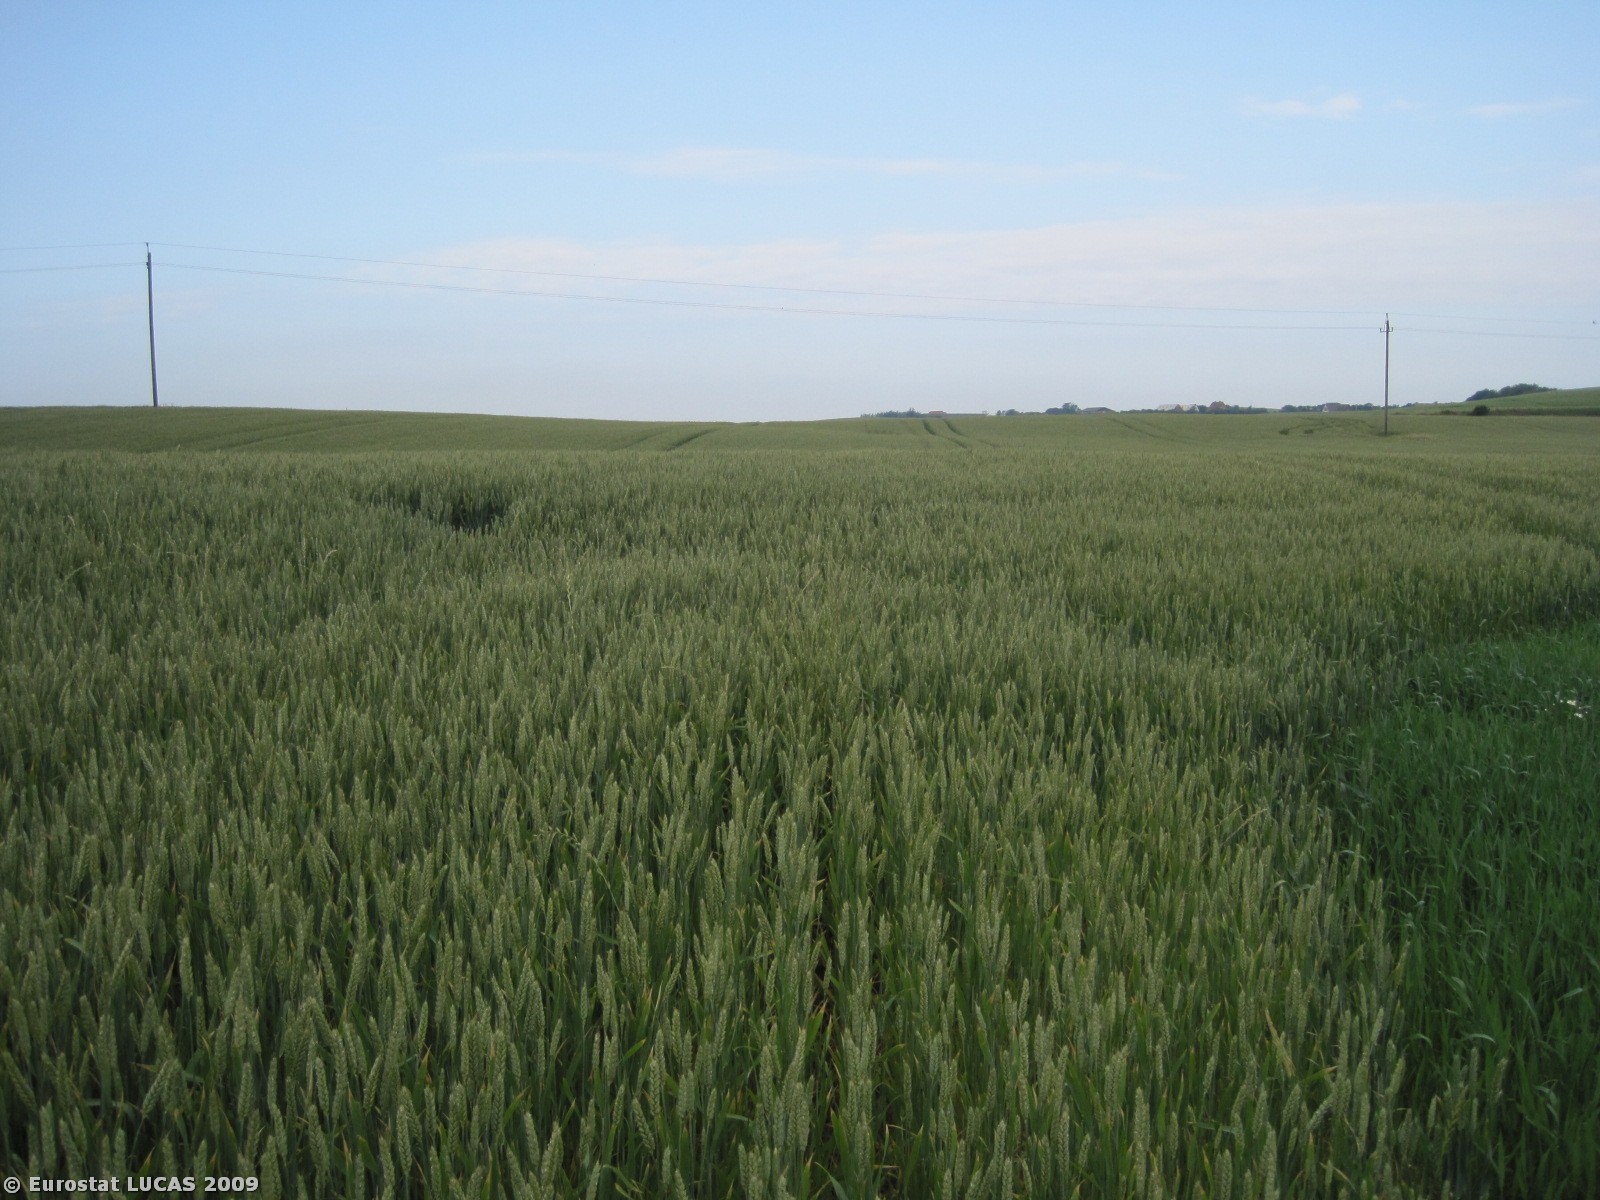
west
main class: Cropland
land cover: Common wheat
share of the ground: > 75 %
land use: Agriculture (excluding fallow land and kitchen gardens)
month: June
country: DK
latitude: 56.5549
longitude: 8.3589
